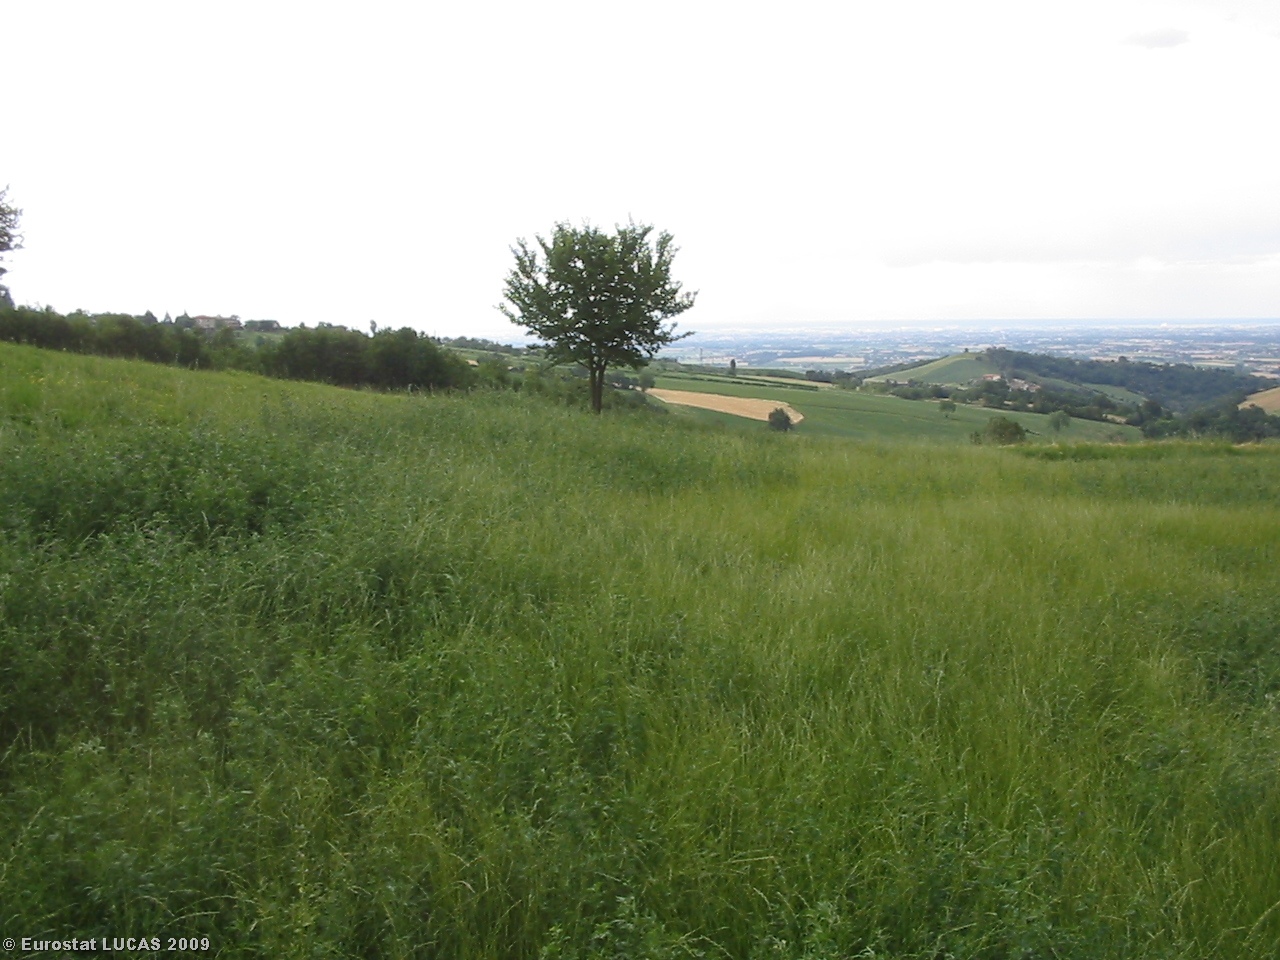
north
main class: Cropland
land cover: Lucerne
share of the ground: > 75 %
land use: Agriculture (excluding fallow land and kitchen gardens)
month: June
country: IT
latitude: 44.6569
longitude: 10.2391
